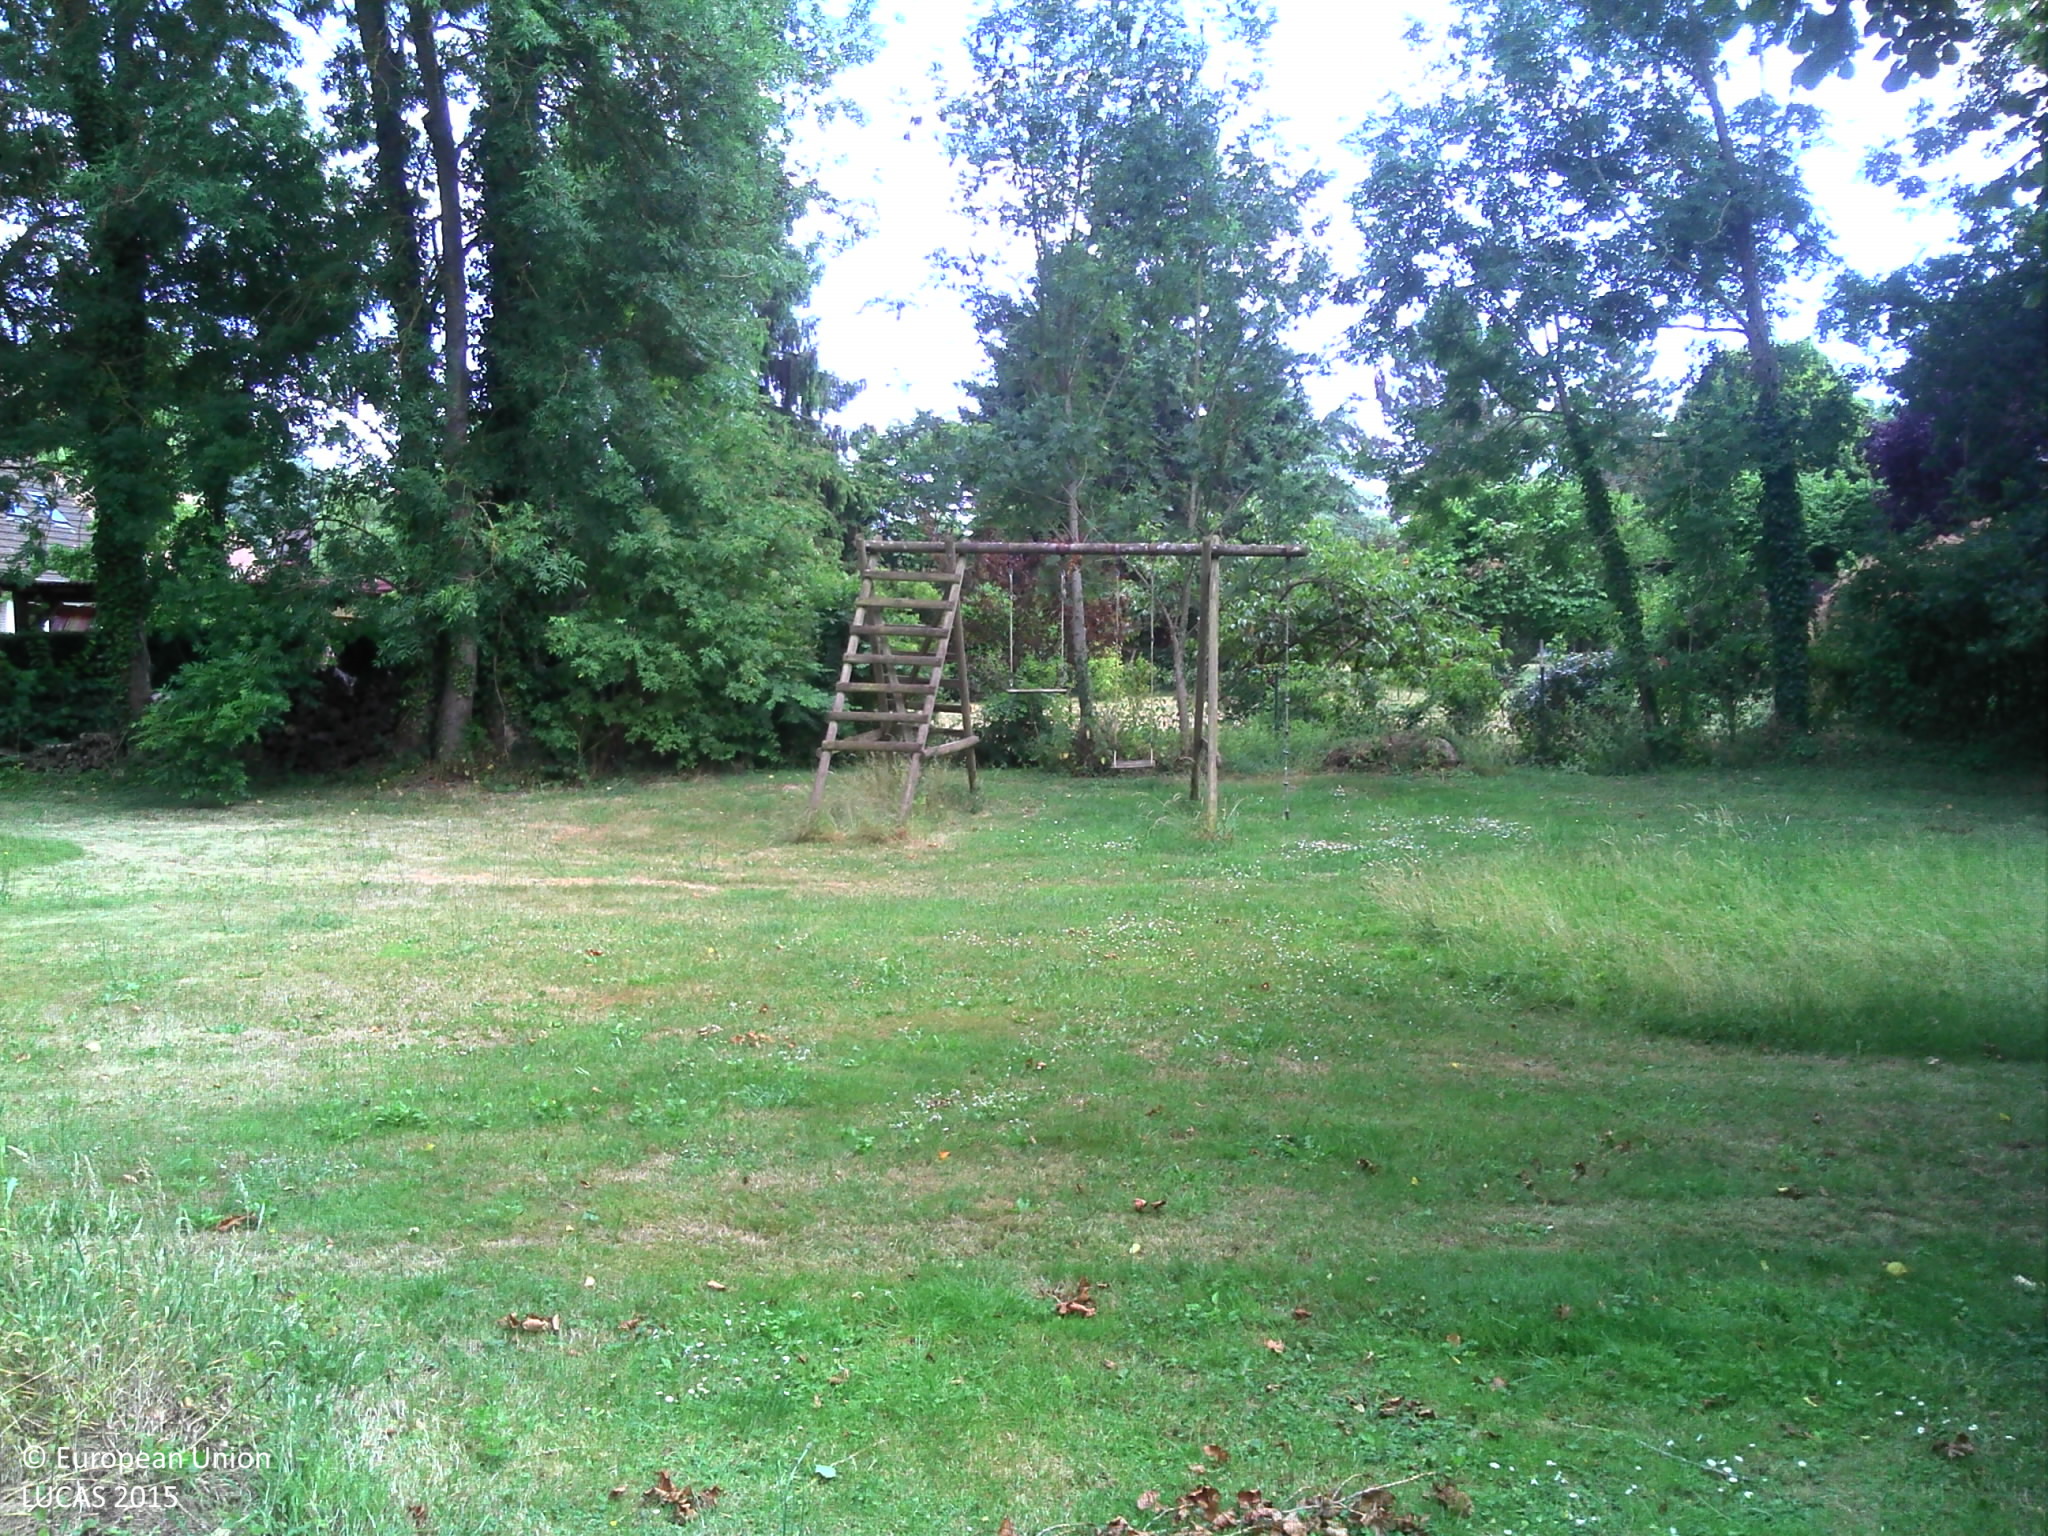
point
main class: Grassland
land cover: Grassland without tree/shrub cover
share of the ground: > 75 %
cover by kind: herbaceous plants 100 %
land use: Residential
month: June
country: FR
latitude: 49.0724
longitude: 1.2882
